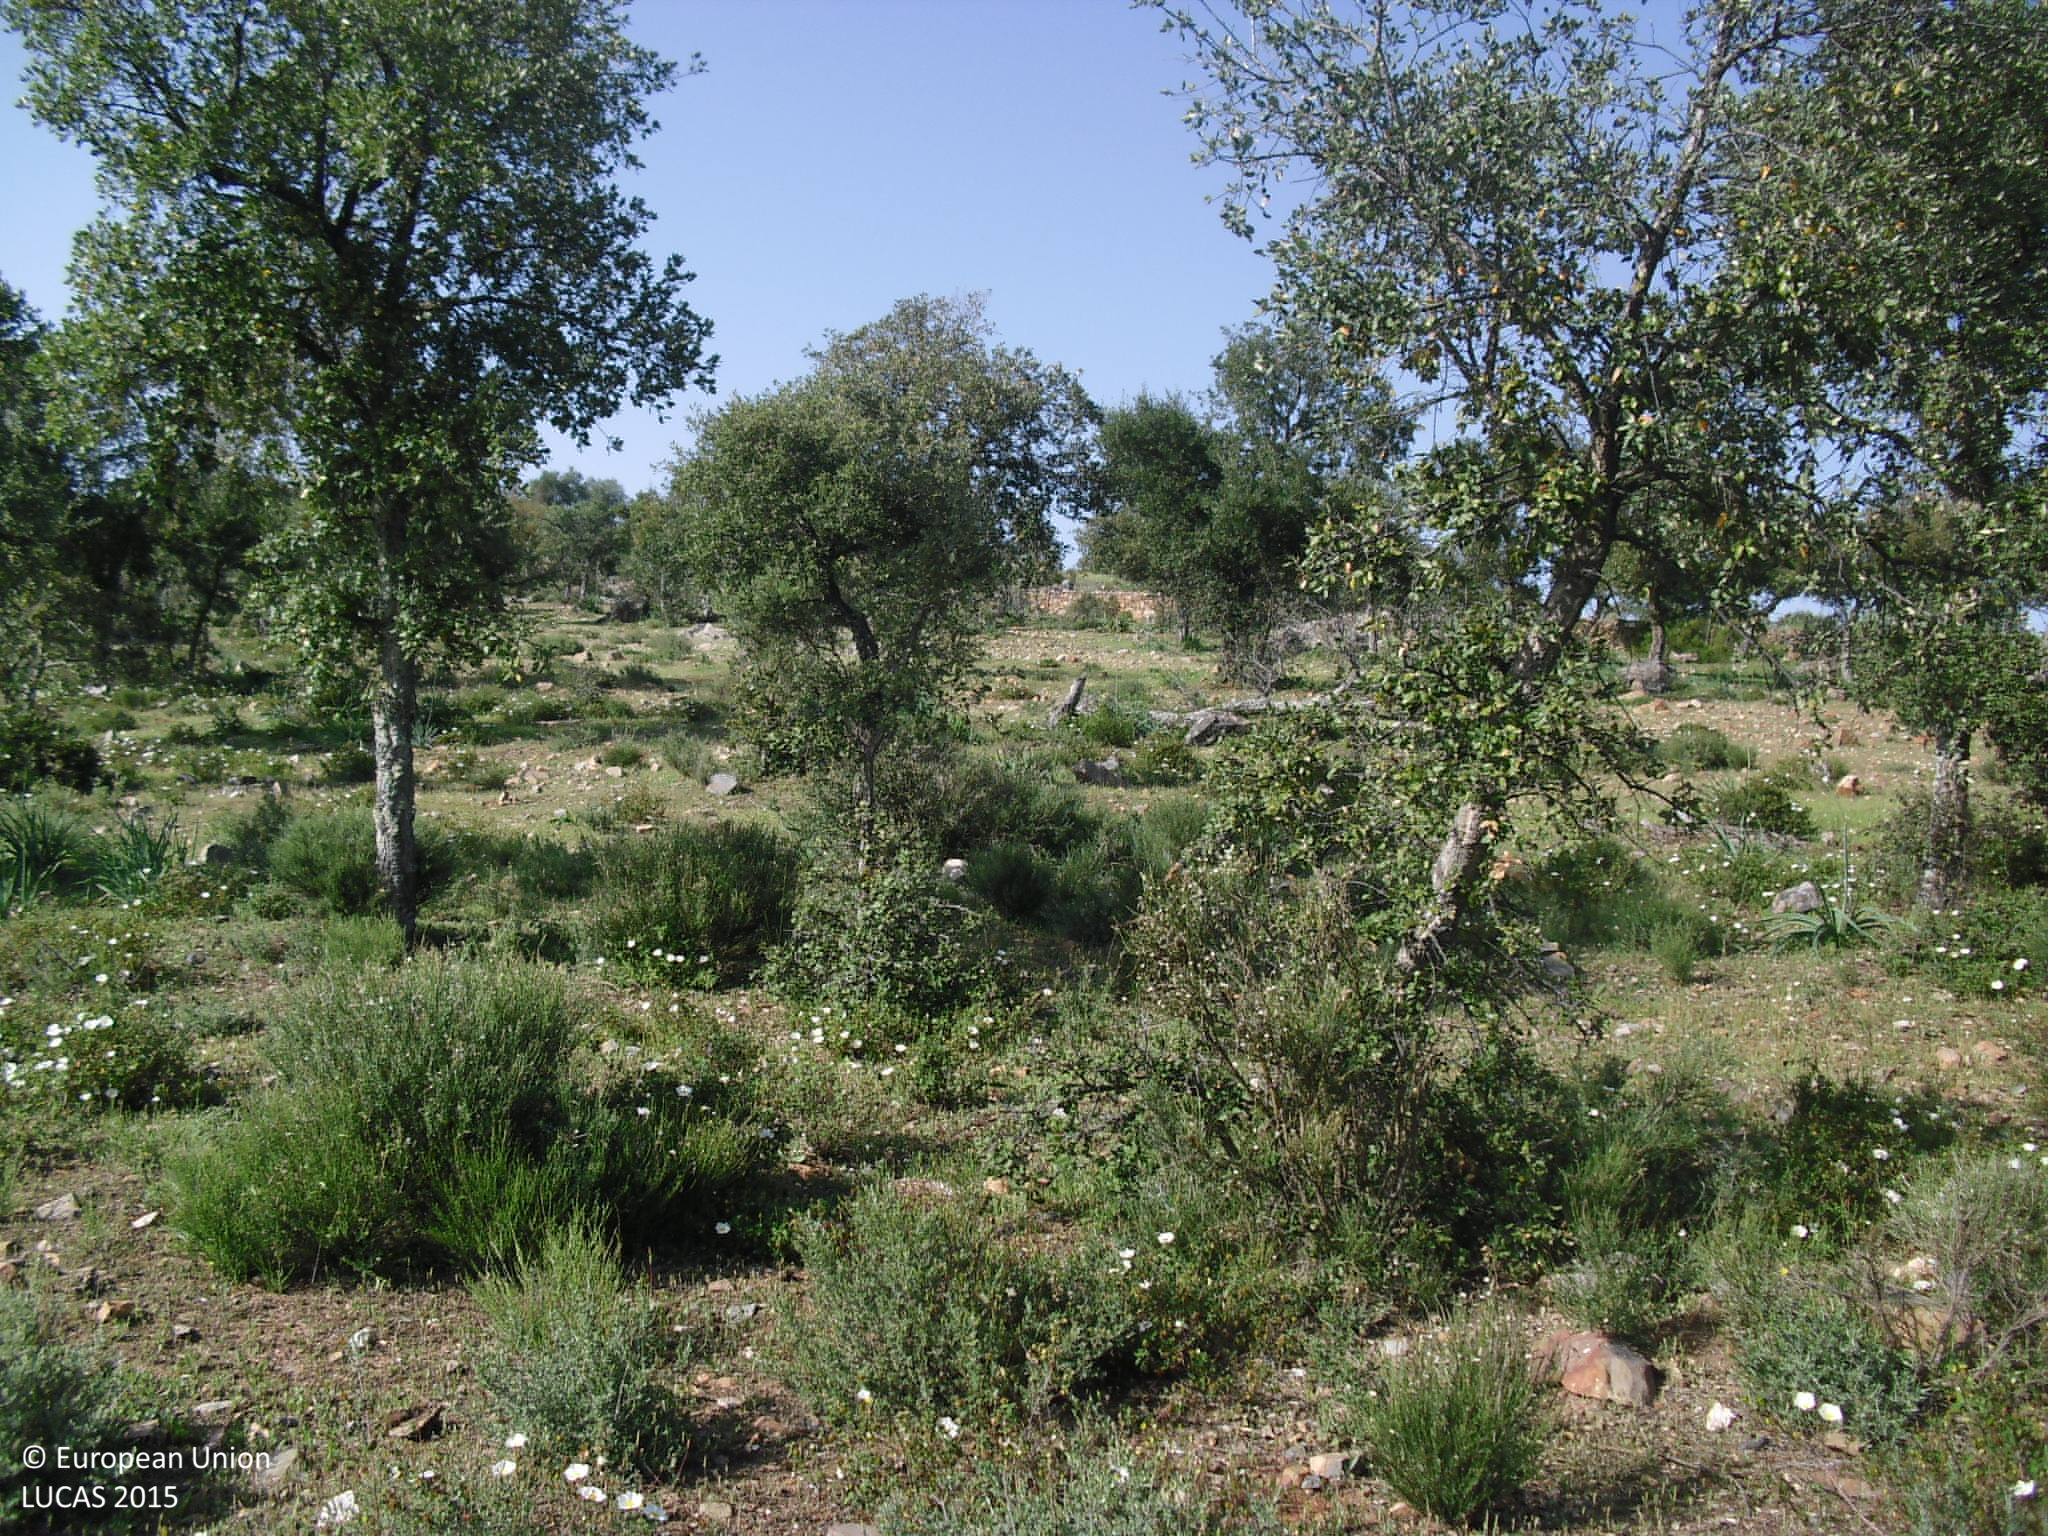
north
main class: Woodland
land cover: Broadleaved woodland
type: broadleaved evergreen forest
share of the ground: 25 - 50 %
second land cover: Grassland without tree/shrub cover
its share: > 75 %
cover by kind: herbaceous plants 60 %, broadleaved forest trees 30 %, shrubs 10 %
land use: Forestry
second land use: Agriculture (excluding fallow land and kitchen gardens)
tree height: > 5 m
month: April
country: ES
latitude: 39.4839
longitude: -6.4036
